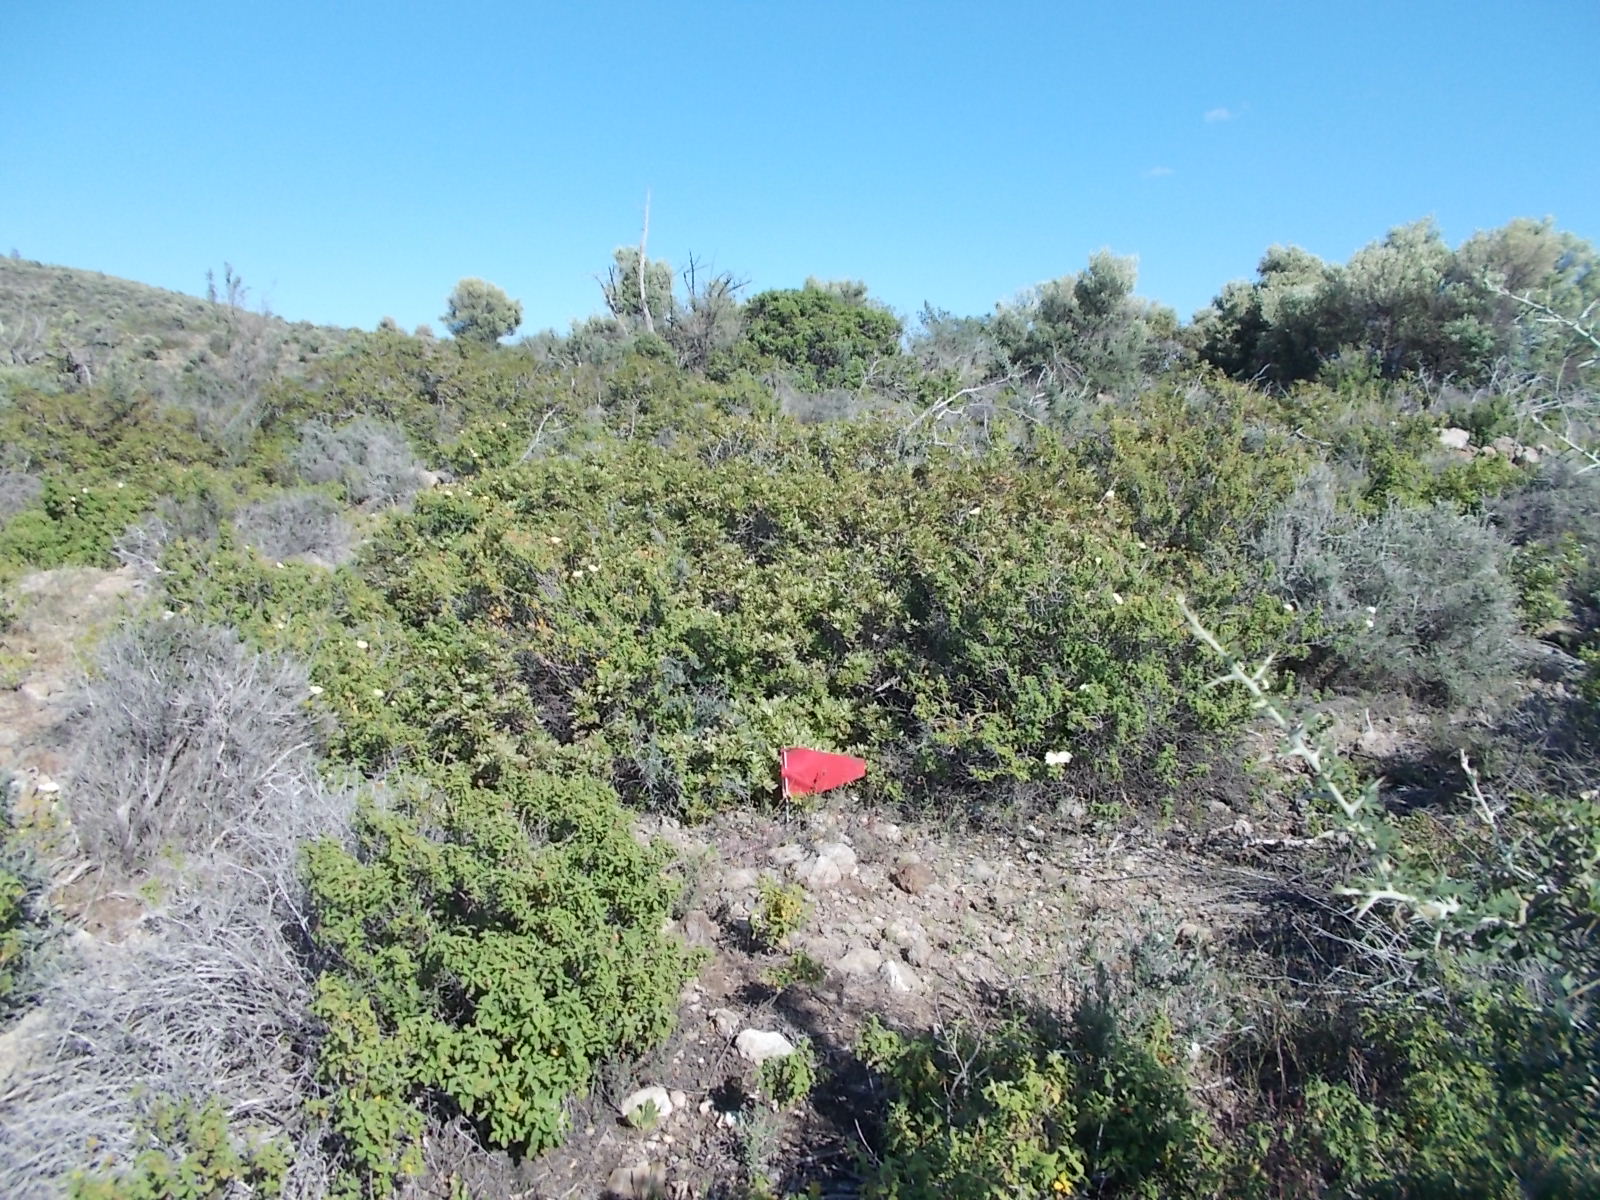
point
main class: Shrubland
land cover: Shrubland with sparse tree cover
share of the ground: > 75 %
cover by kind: shrubs 95 %, broadleaved forest trees 5 %
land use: Forestry
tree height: > 5 m
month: April
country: CY
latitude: 34.7728
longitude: 33.0826
